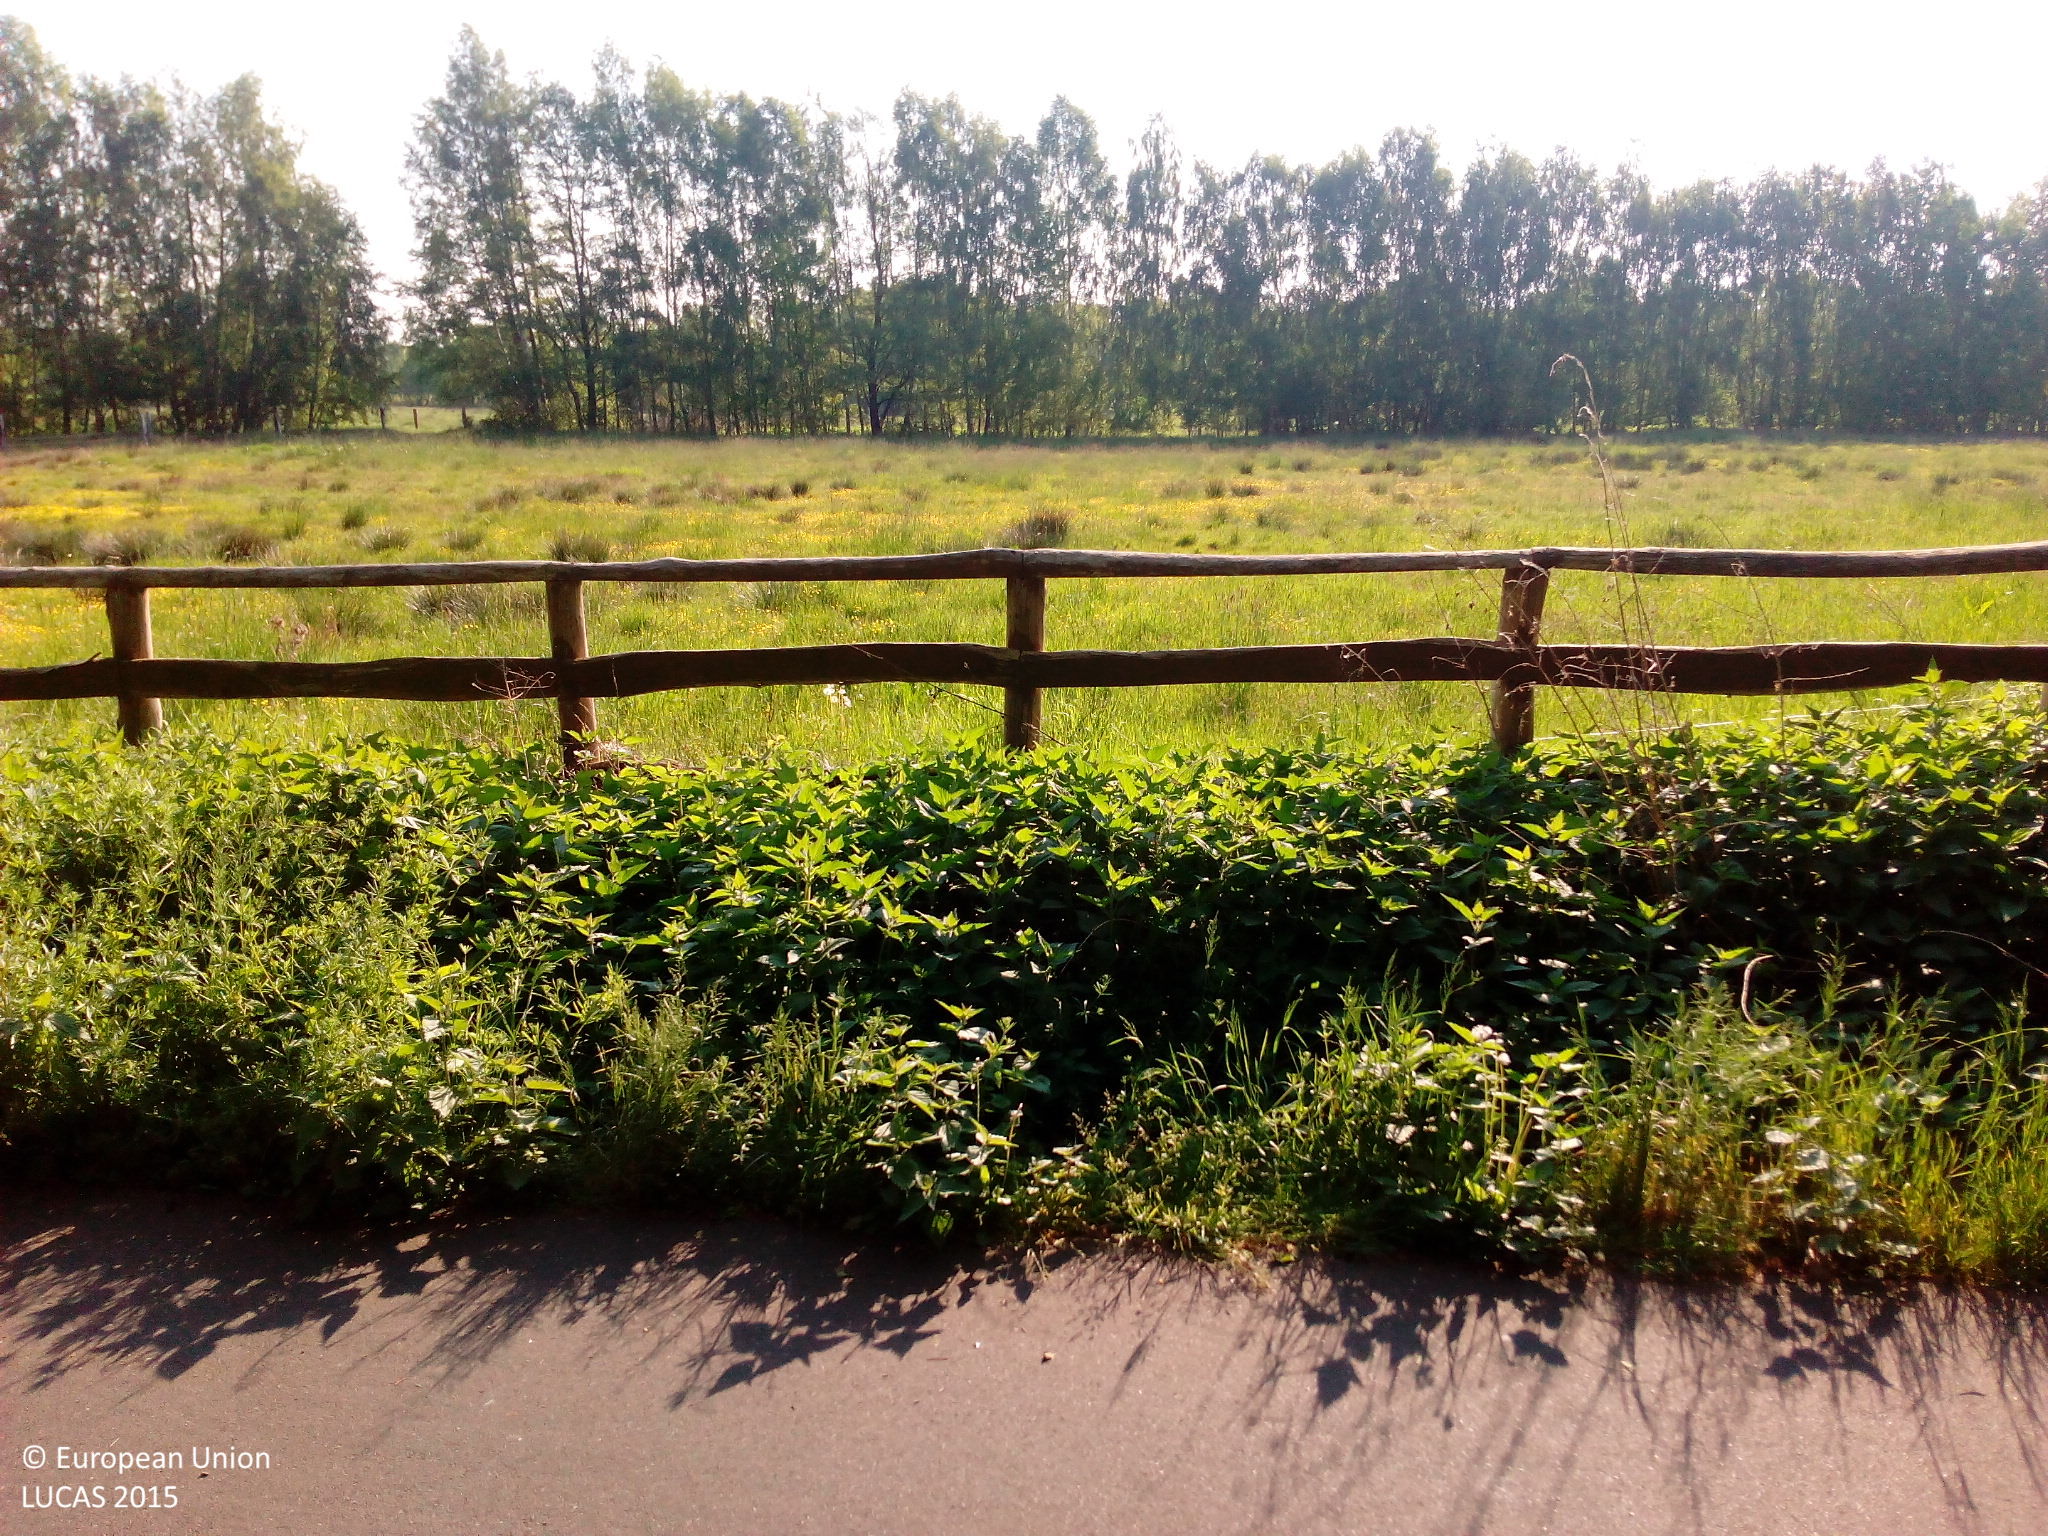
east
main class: Grassland
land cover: Grassland without tree/shrub cover
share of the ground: 50 - 75 %
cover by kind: herbaceous plants 100 %
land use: Agriculture (excluding fallow land and kitchen gardens)
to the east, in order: Grassland without tree/shrub cover; Fences; Grass margins; Paved roads, cycling and walking lanes; Spontaneously vegetated surfaces; Fences; Grassland without tree/shrub cover; Fences; Lines of trees; Ditches and canals; Lines of trees; Fences; Grassland without tree/shrub cover
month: May
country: DE
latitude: 52.0655
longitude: 13.1654
